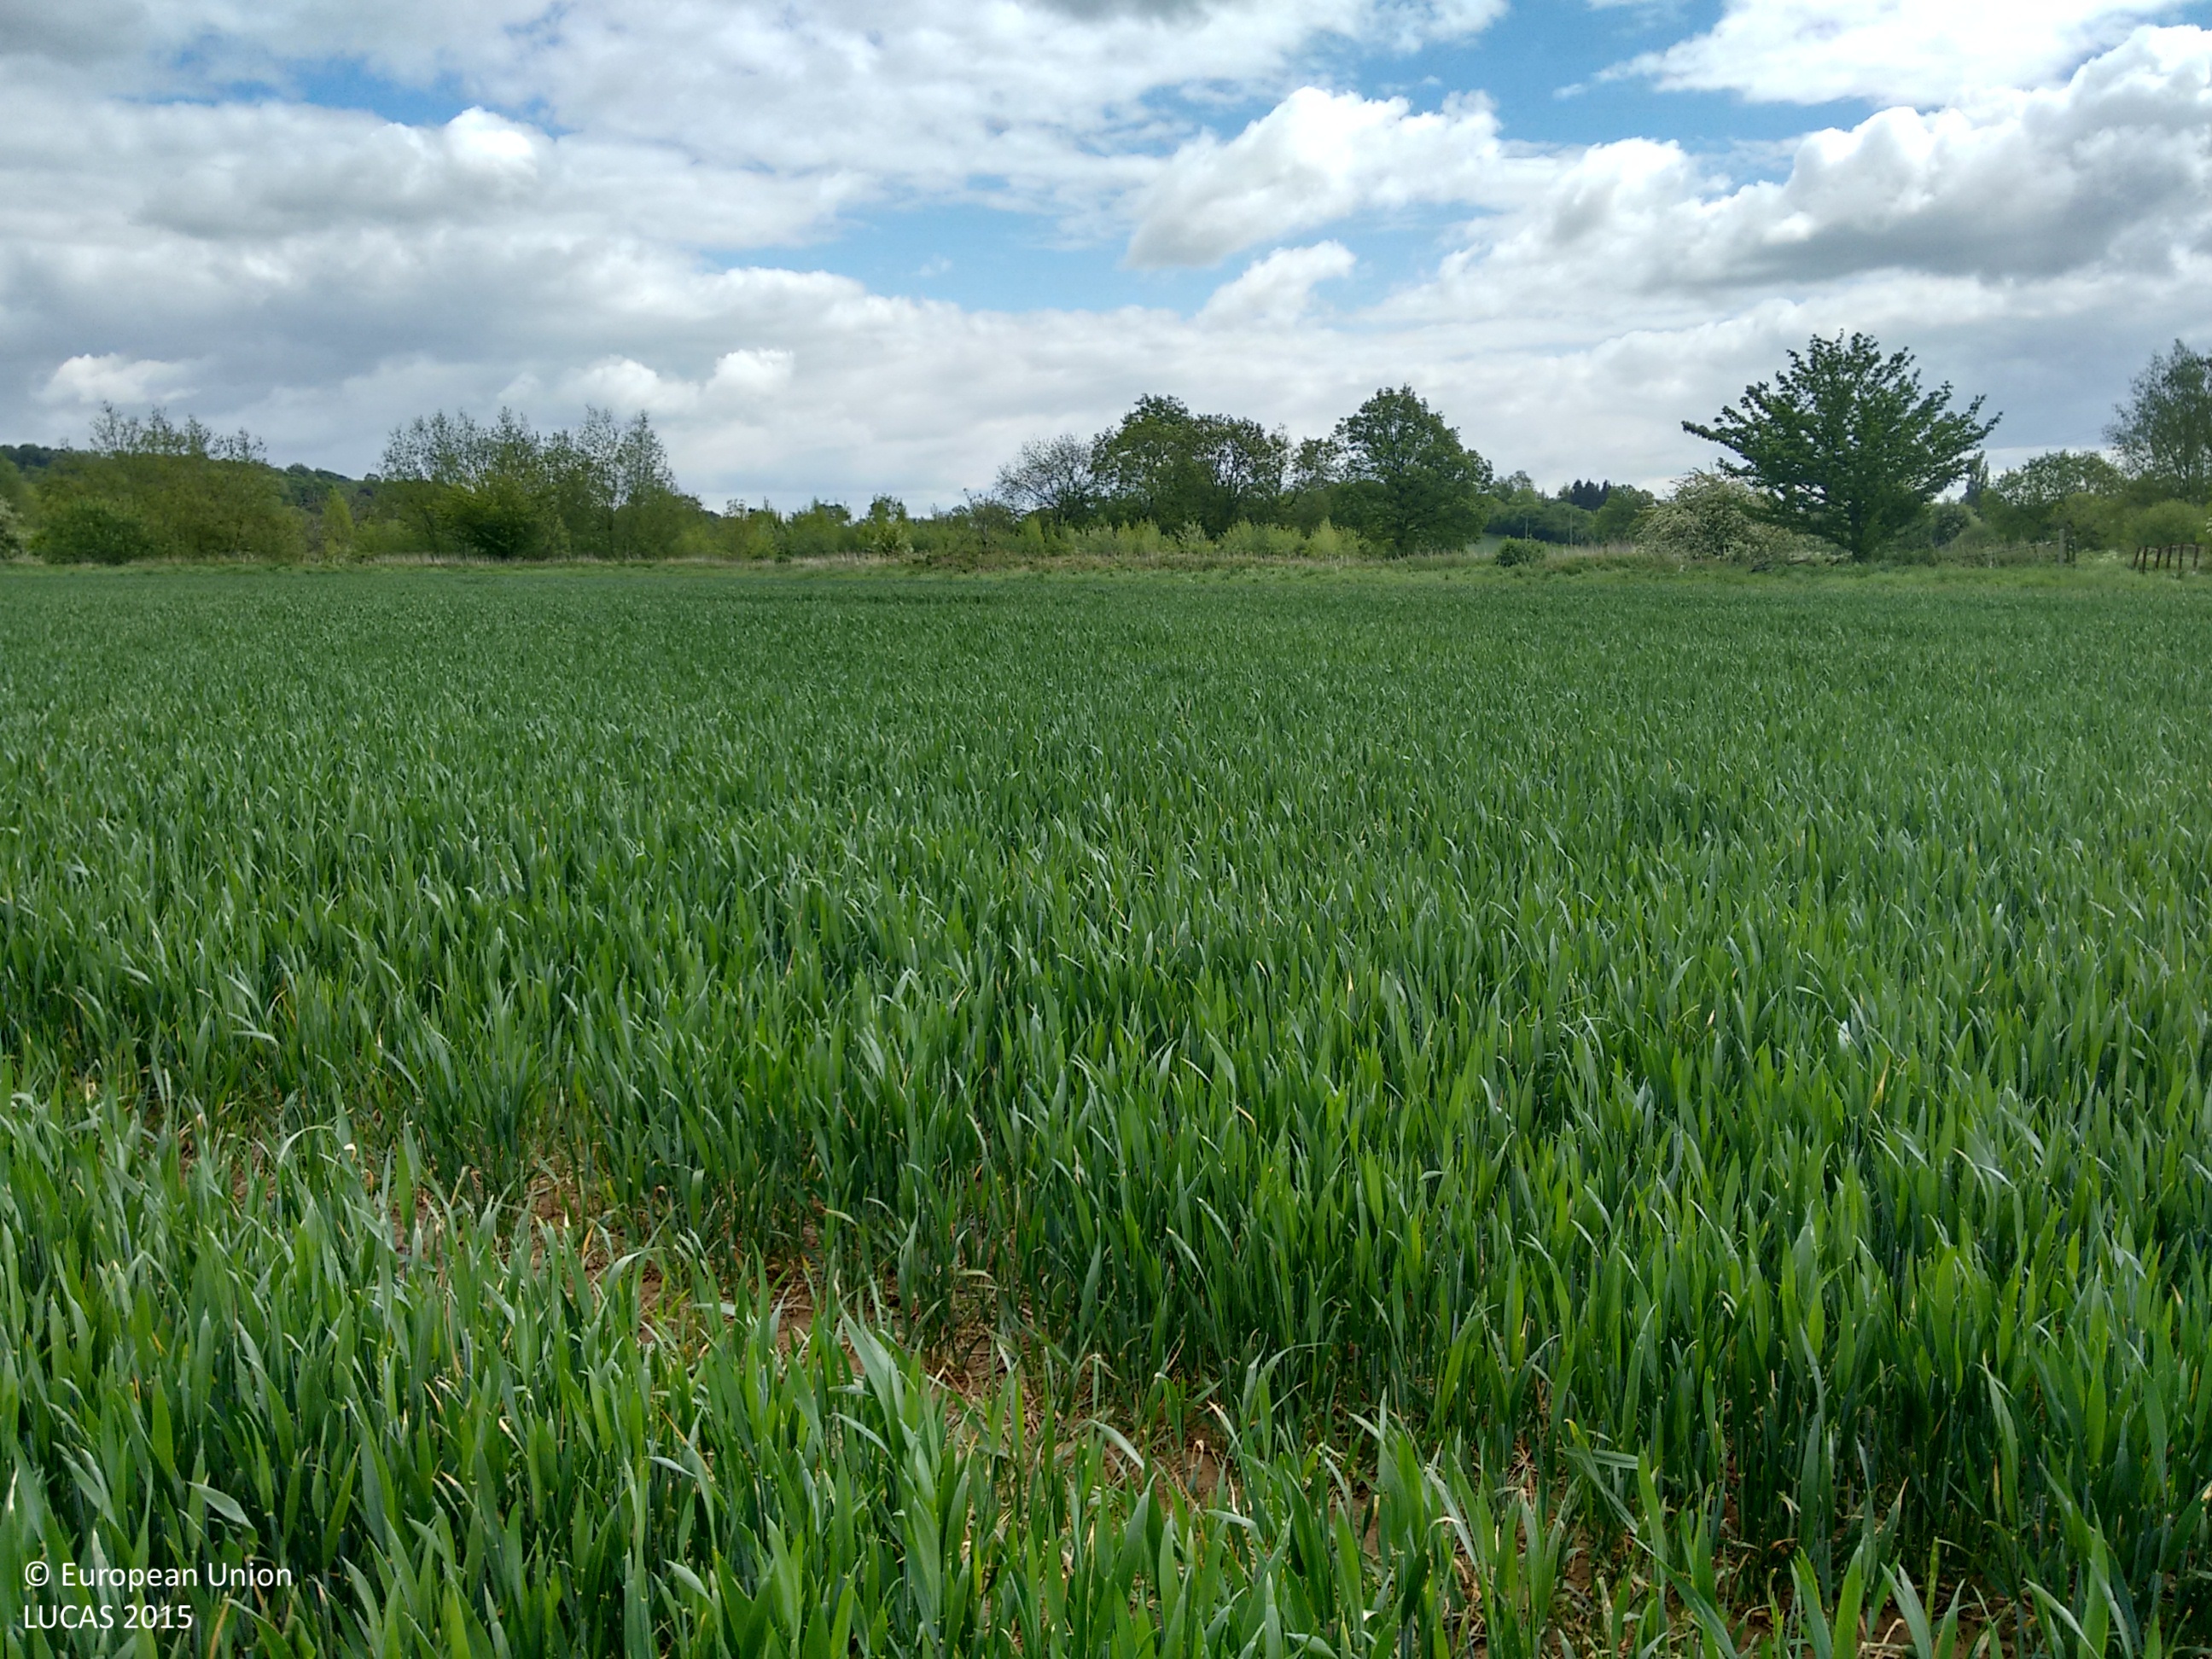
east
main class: Cropland
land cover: Common wheat
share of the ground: > 75 %
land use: Agriculture (excluding fallow land and kitchen gardens)
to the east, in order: Common wheat; Grassland without tree/shrub cover; Shruby margins; Inland fresh running water; Shruby margins; Grassland without tree/shrub cover; Broadleaved woodland; Inland fresh running water; Shrubland without tree cover
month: May
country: GB
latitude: 51.1159
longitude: 0.1547
